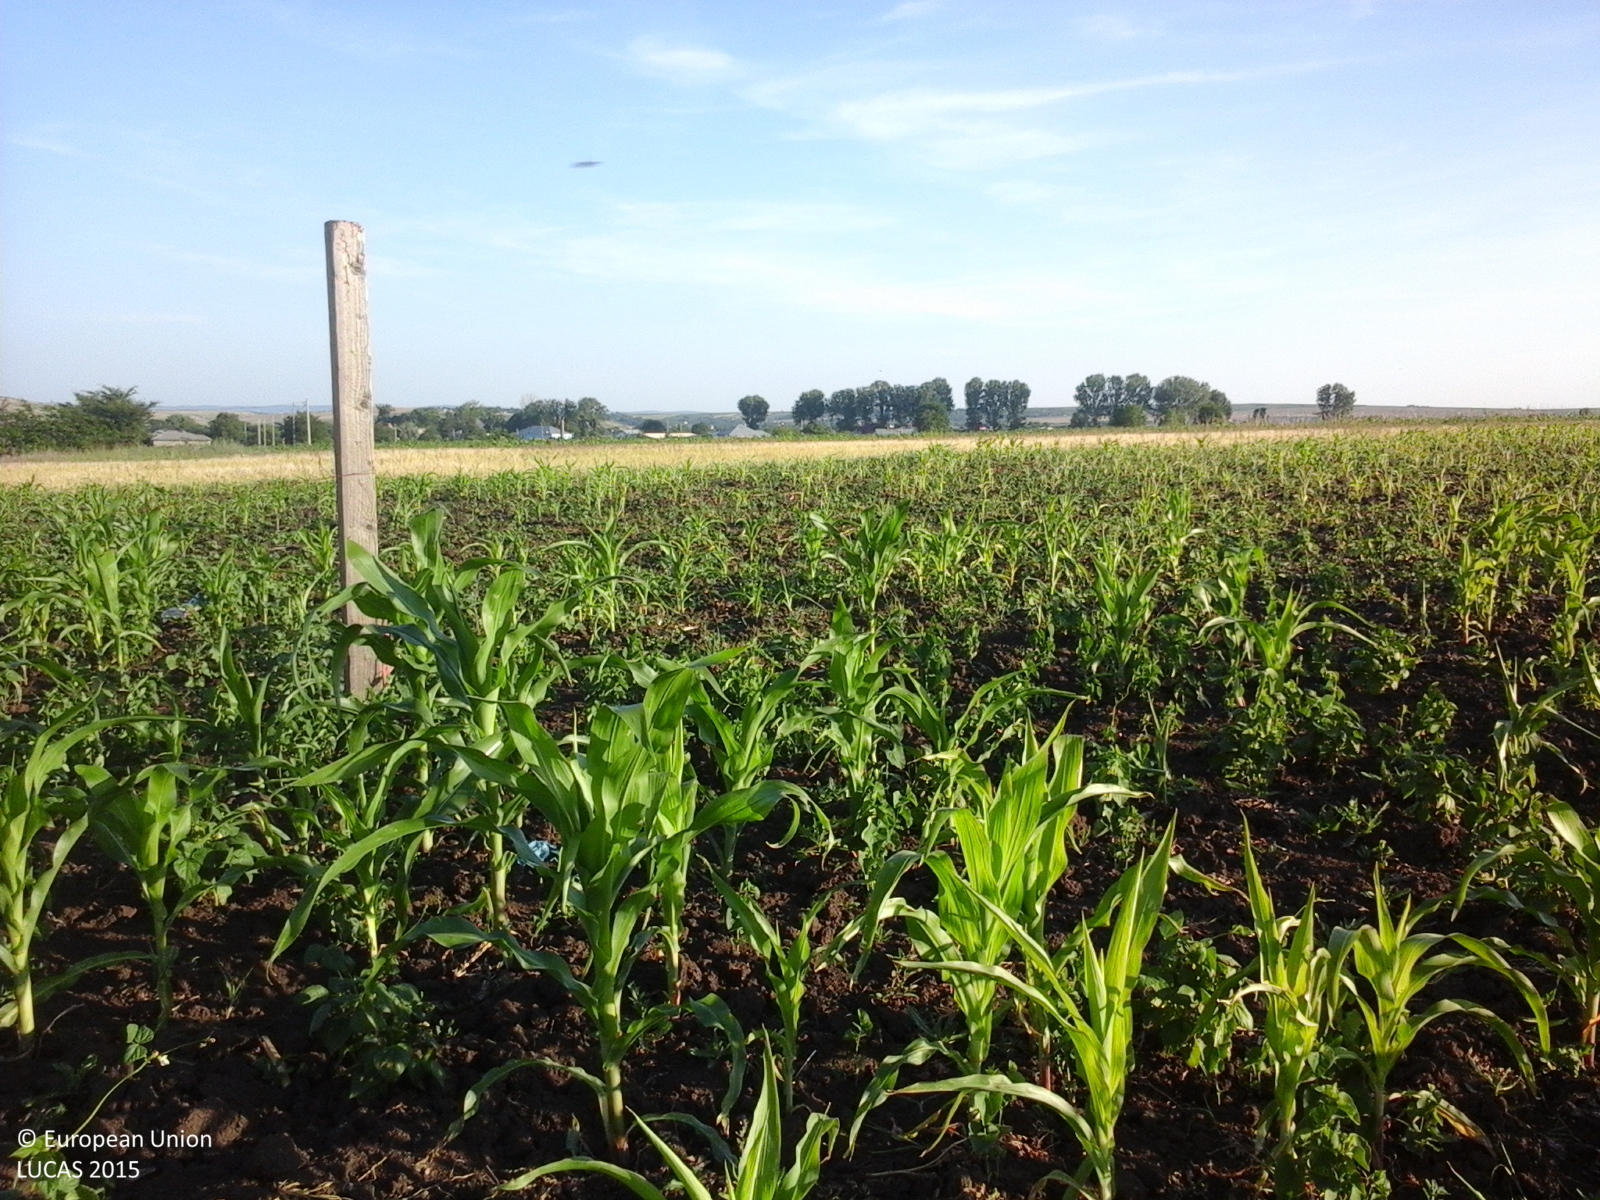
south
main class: Cropland
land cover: Maize
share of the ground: > 75 %
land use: Agriculture (excluding fallow land and kitchen gardens)
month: June
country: RO
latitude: 47.3190
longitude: 27.0782
